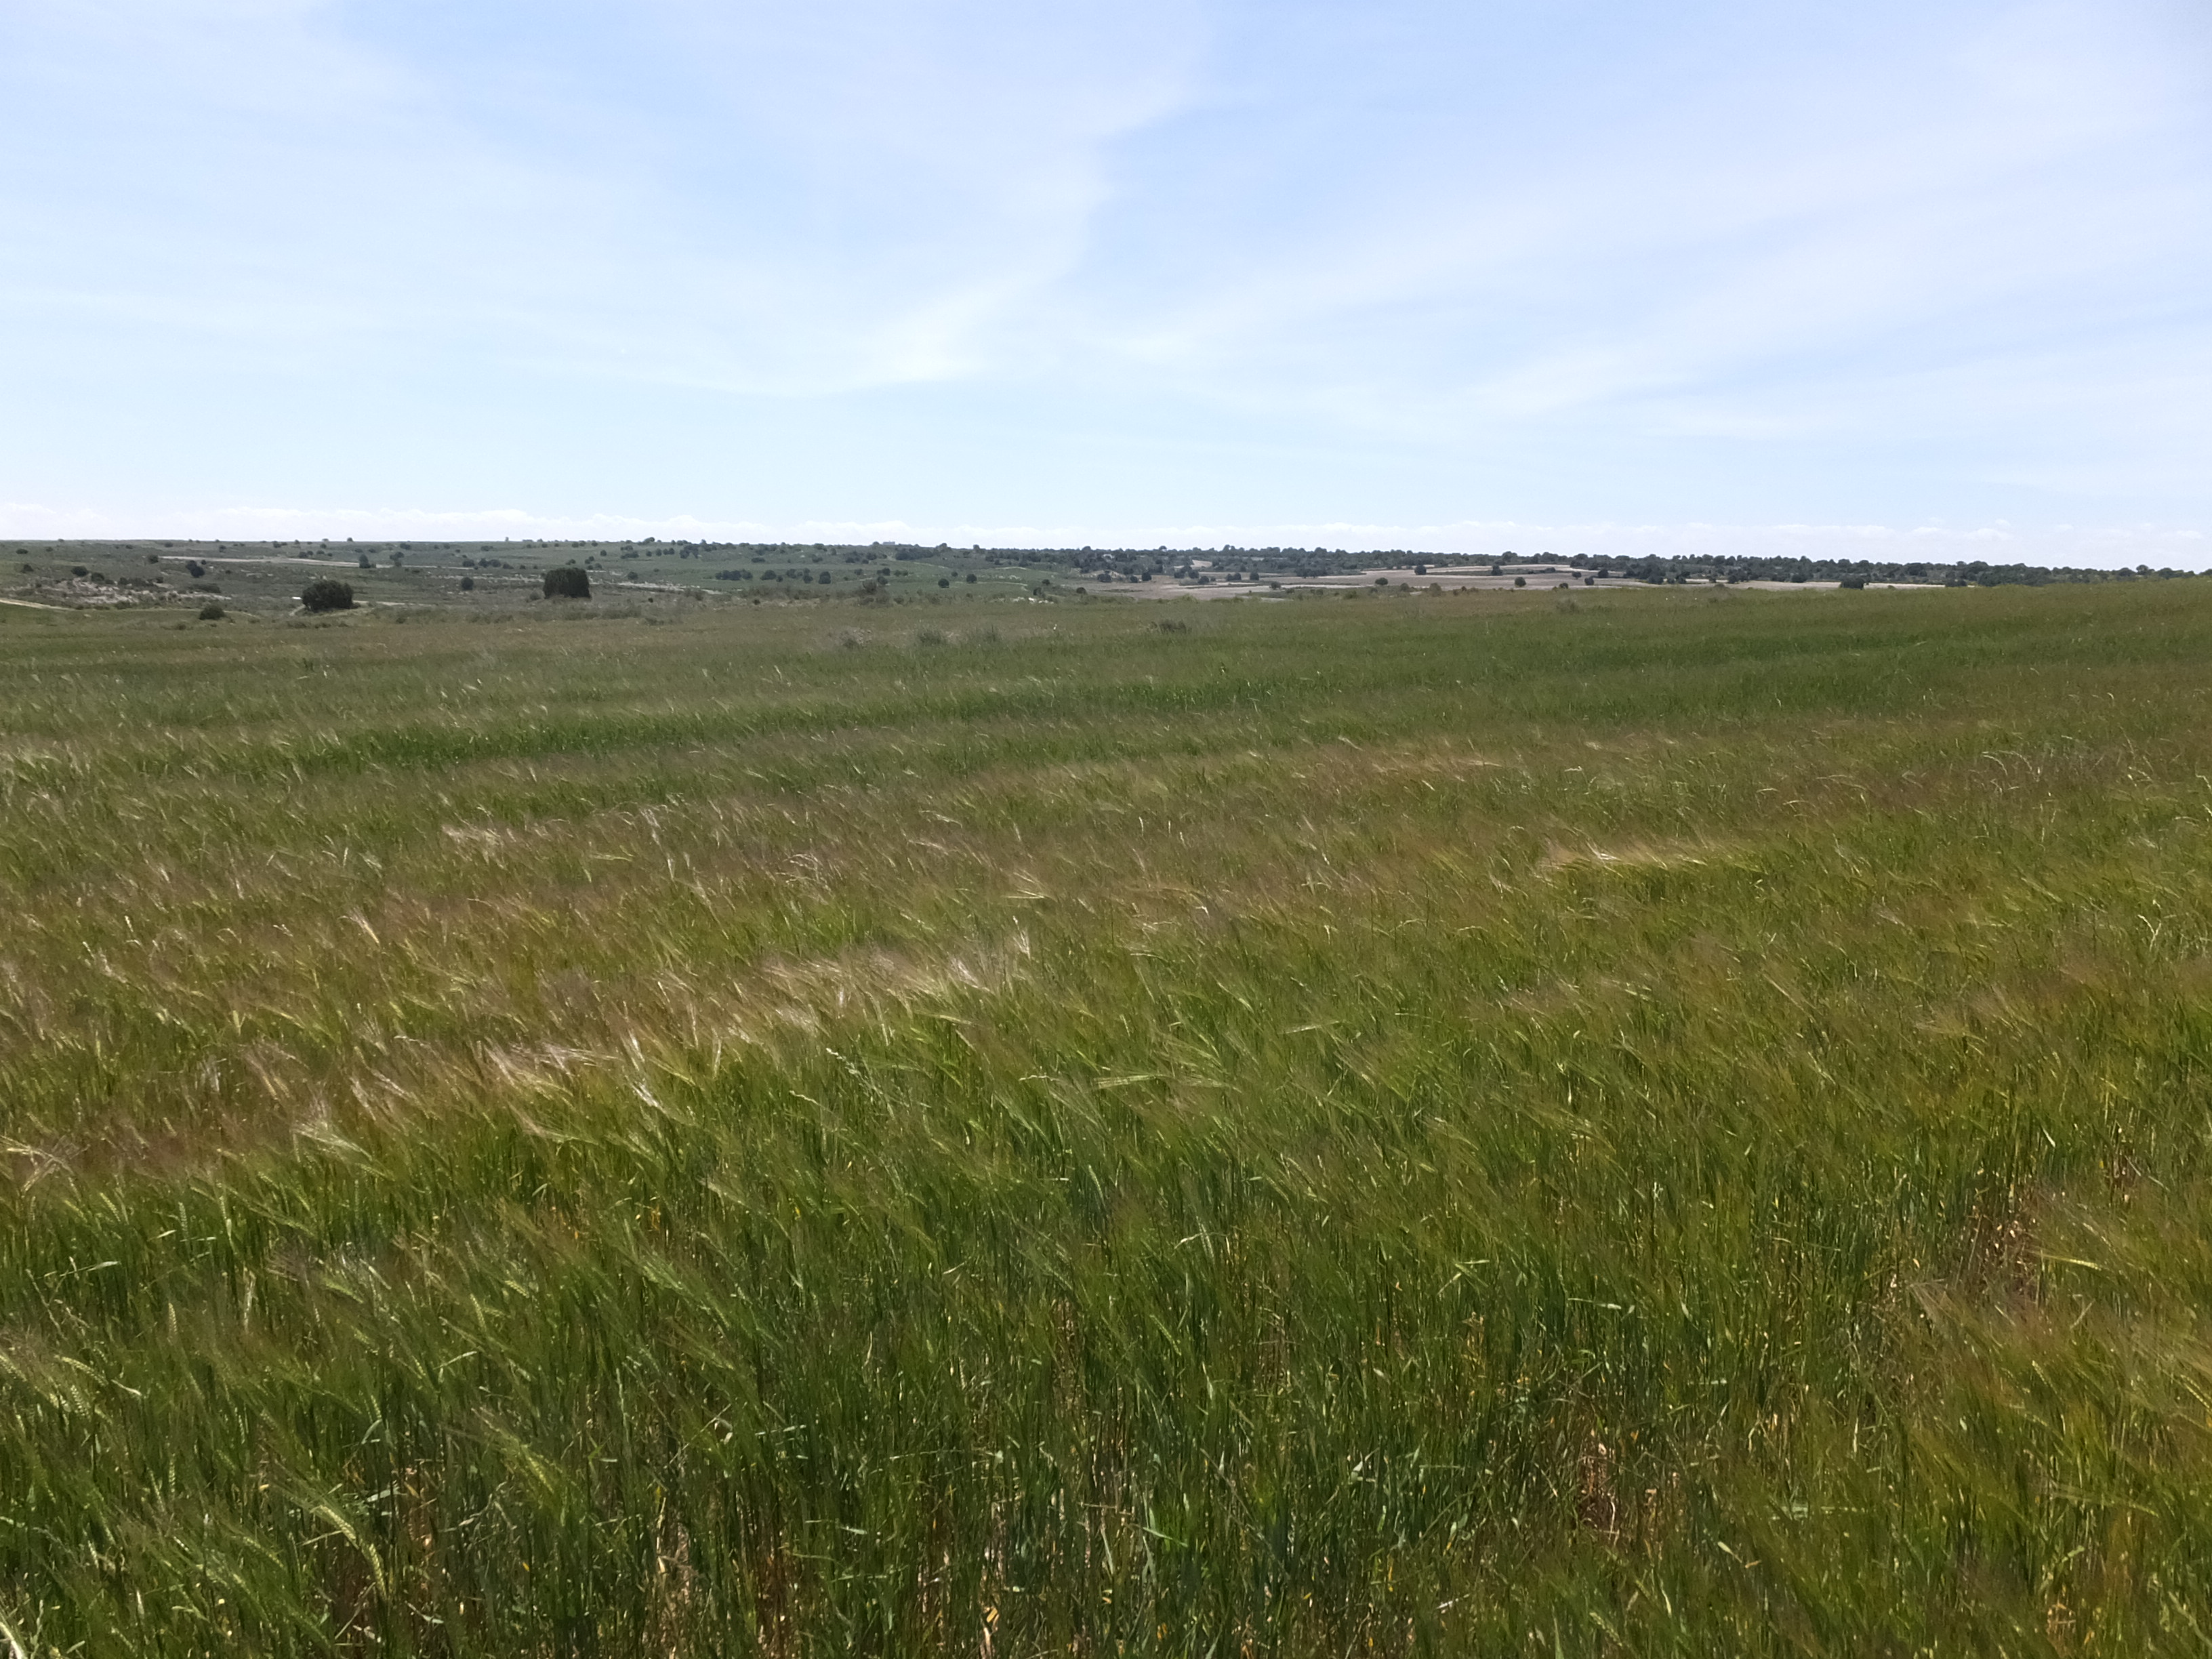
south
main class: Cropland
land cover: Barley
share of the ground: > 75 %
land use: Agriculture (excluding fallow land and kitchen gardens)
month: April
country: ES
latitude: 41.4975
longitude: -0.2340
